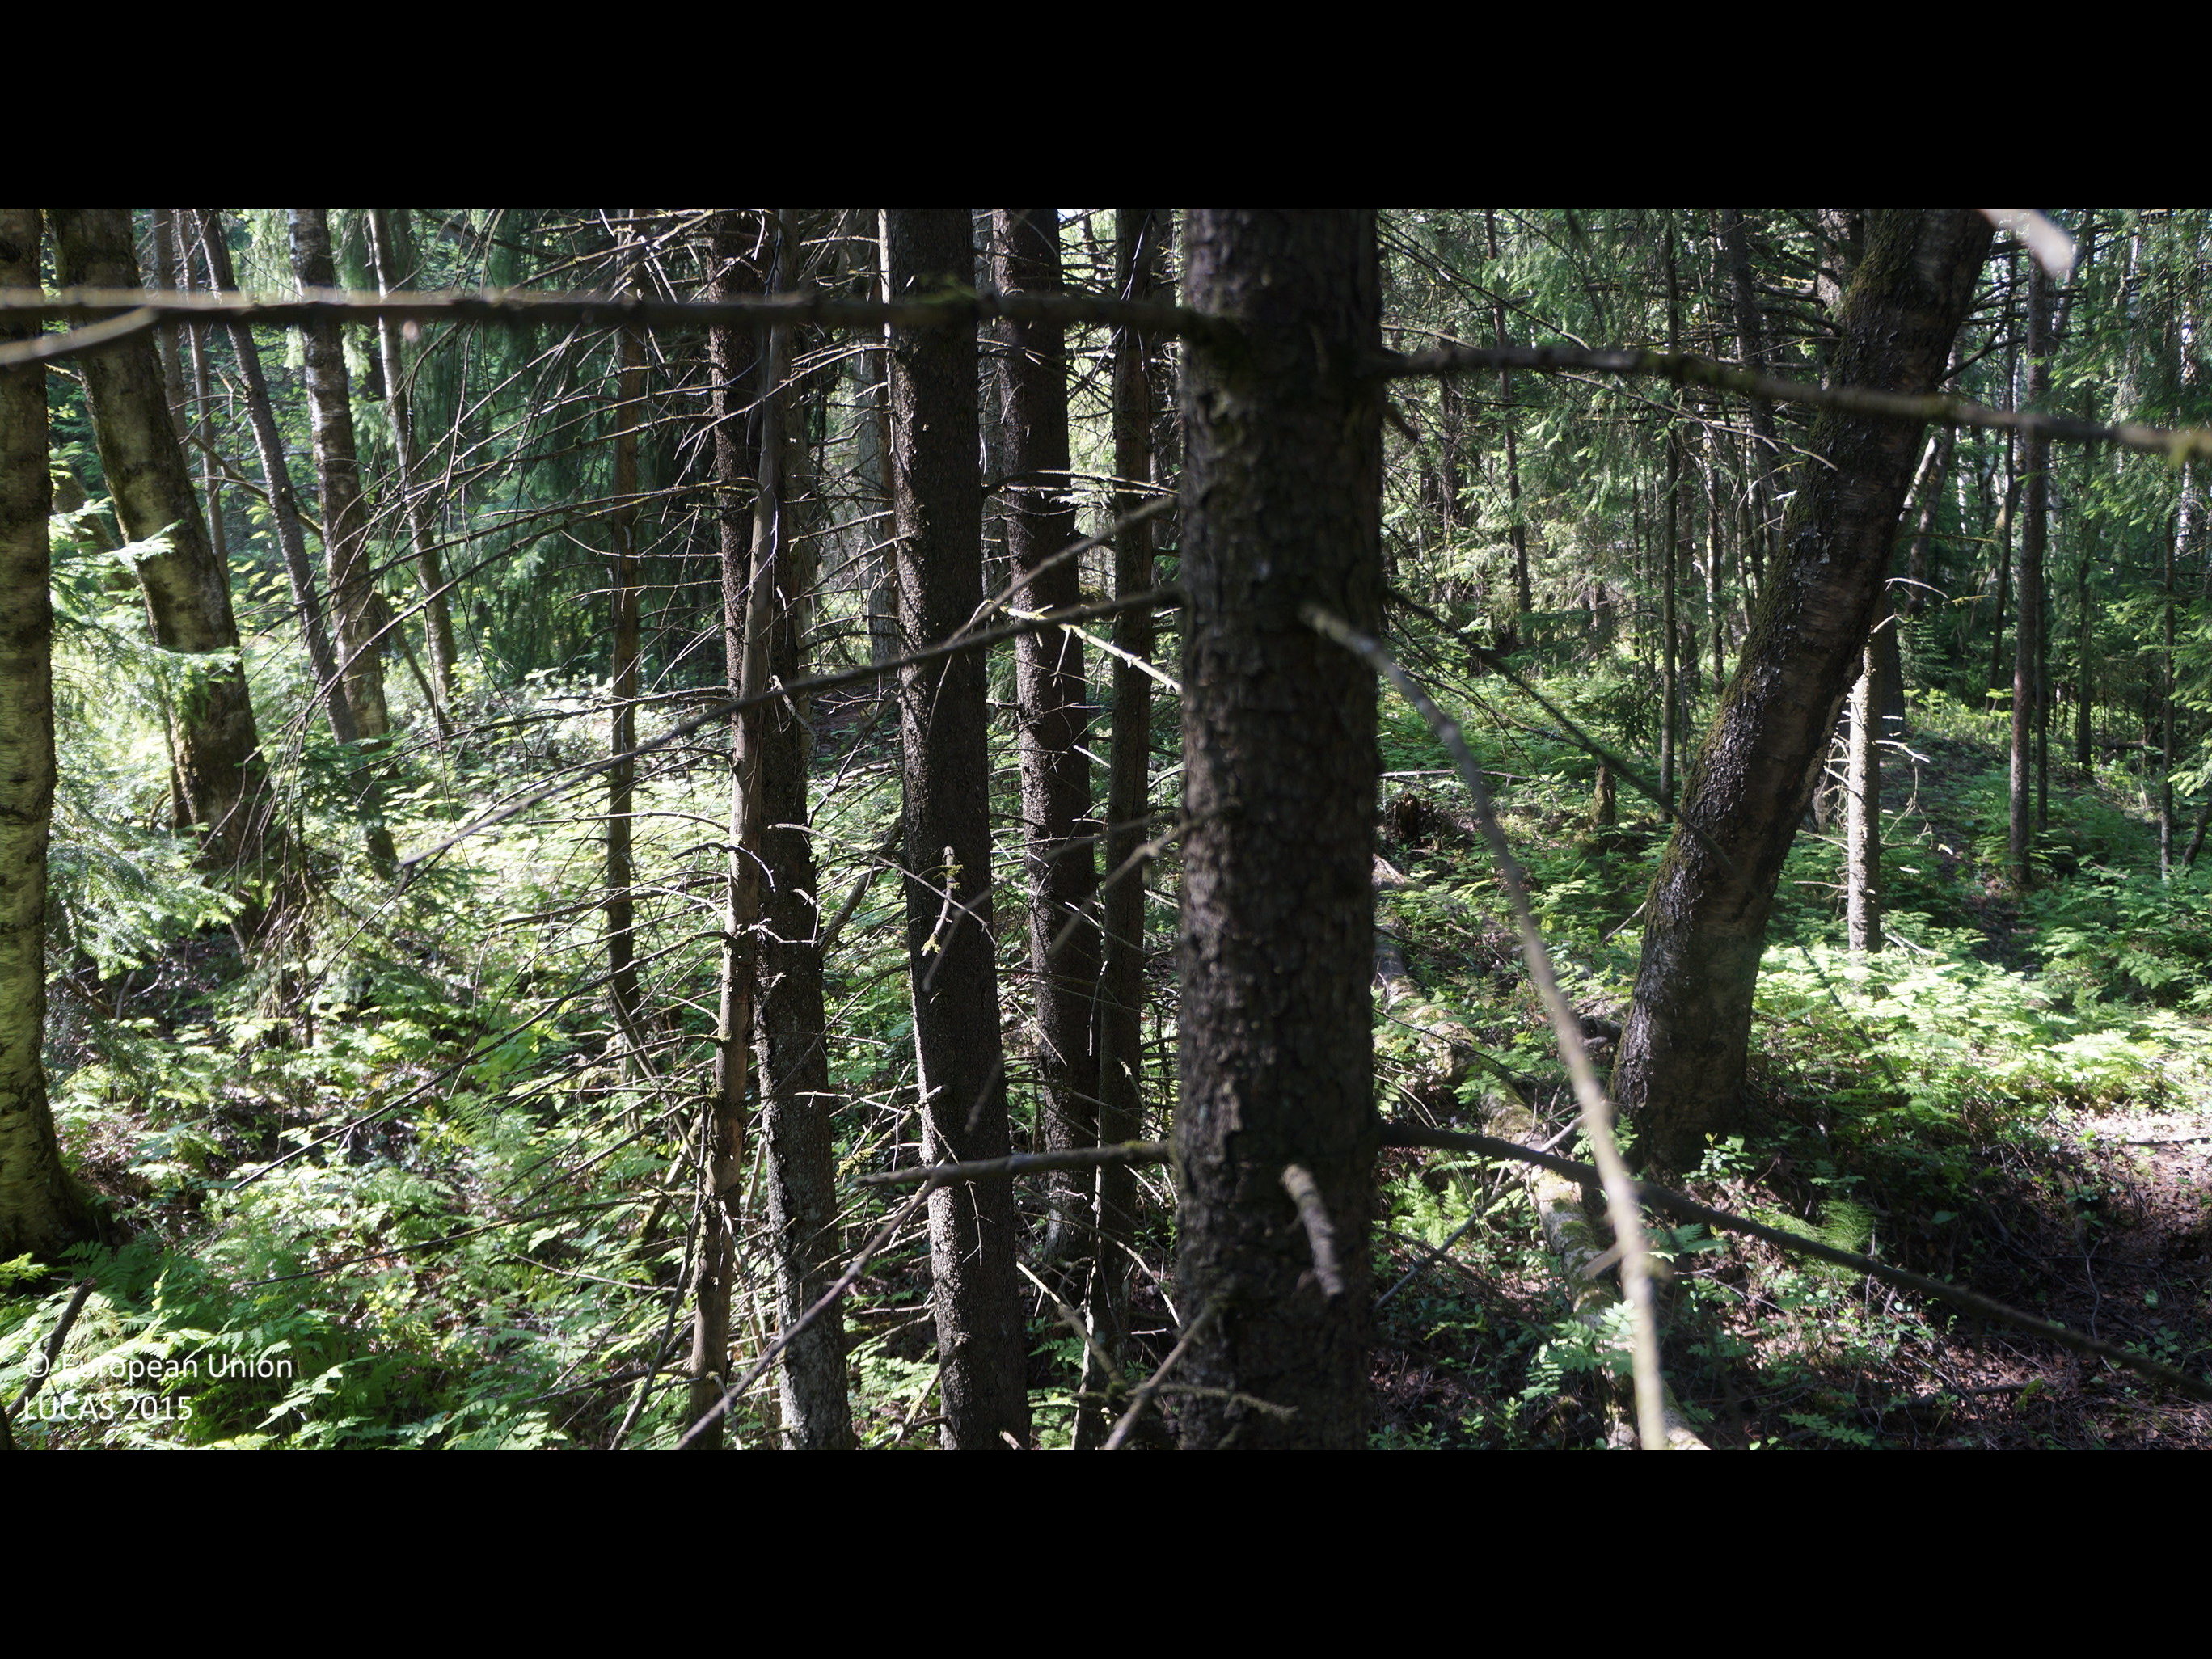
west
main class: Woodland
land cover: Spruce dominated mixed woodland
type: boreal forest
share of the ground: > 75 %
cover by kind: coniferous forest trees 60 %, broadleaved forest trees 20 %, shrubs 10 %, herbaceous plants 5 %, lichens and mosses 5 %
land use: Forestry
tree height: > 5 m
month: July
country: FI
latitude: 64.6537
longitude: 24.4495
